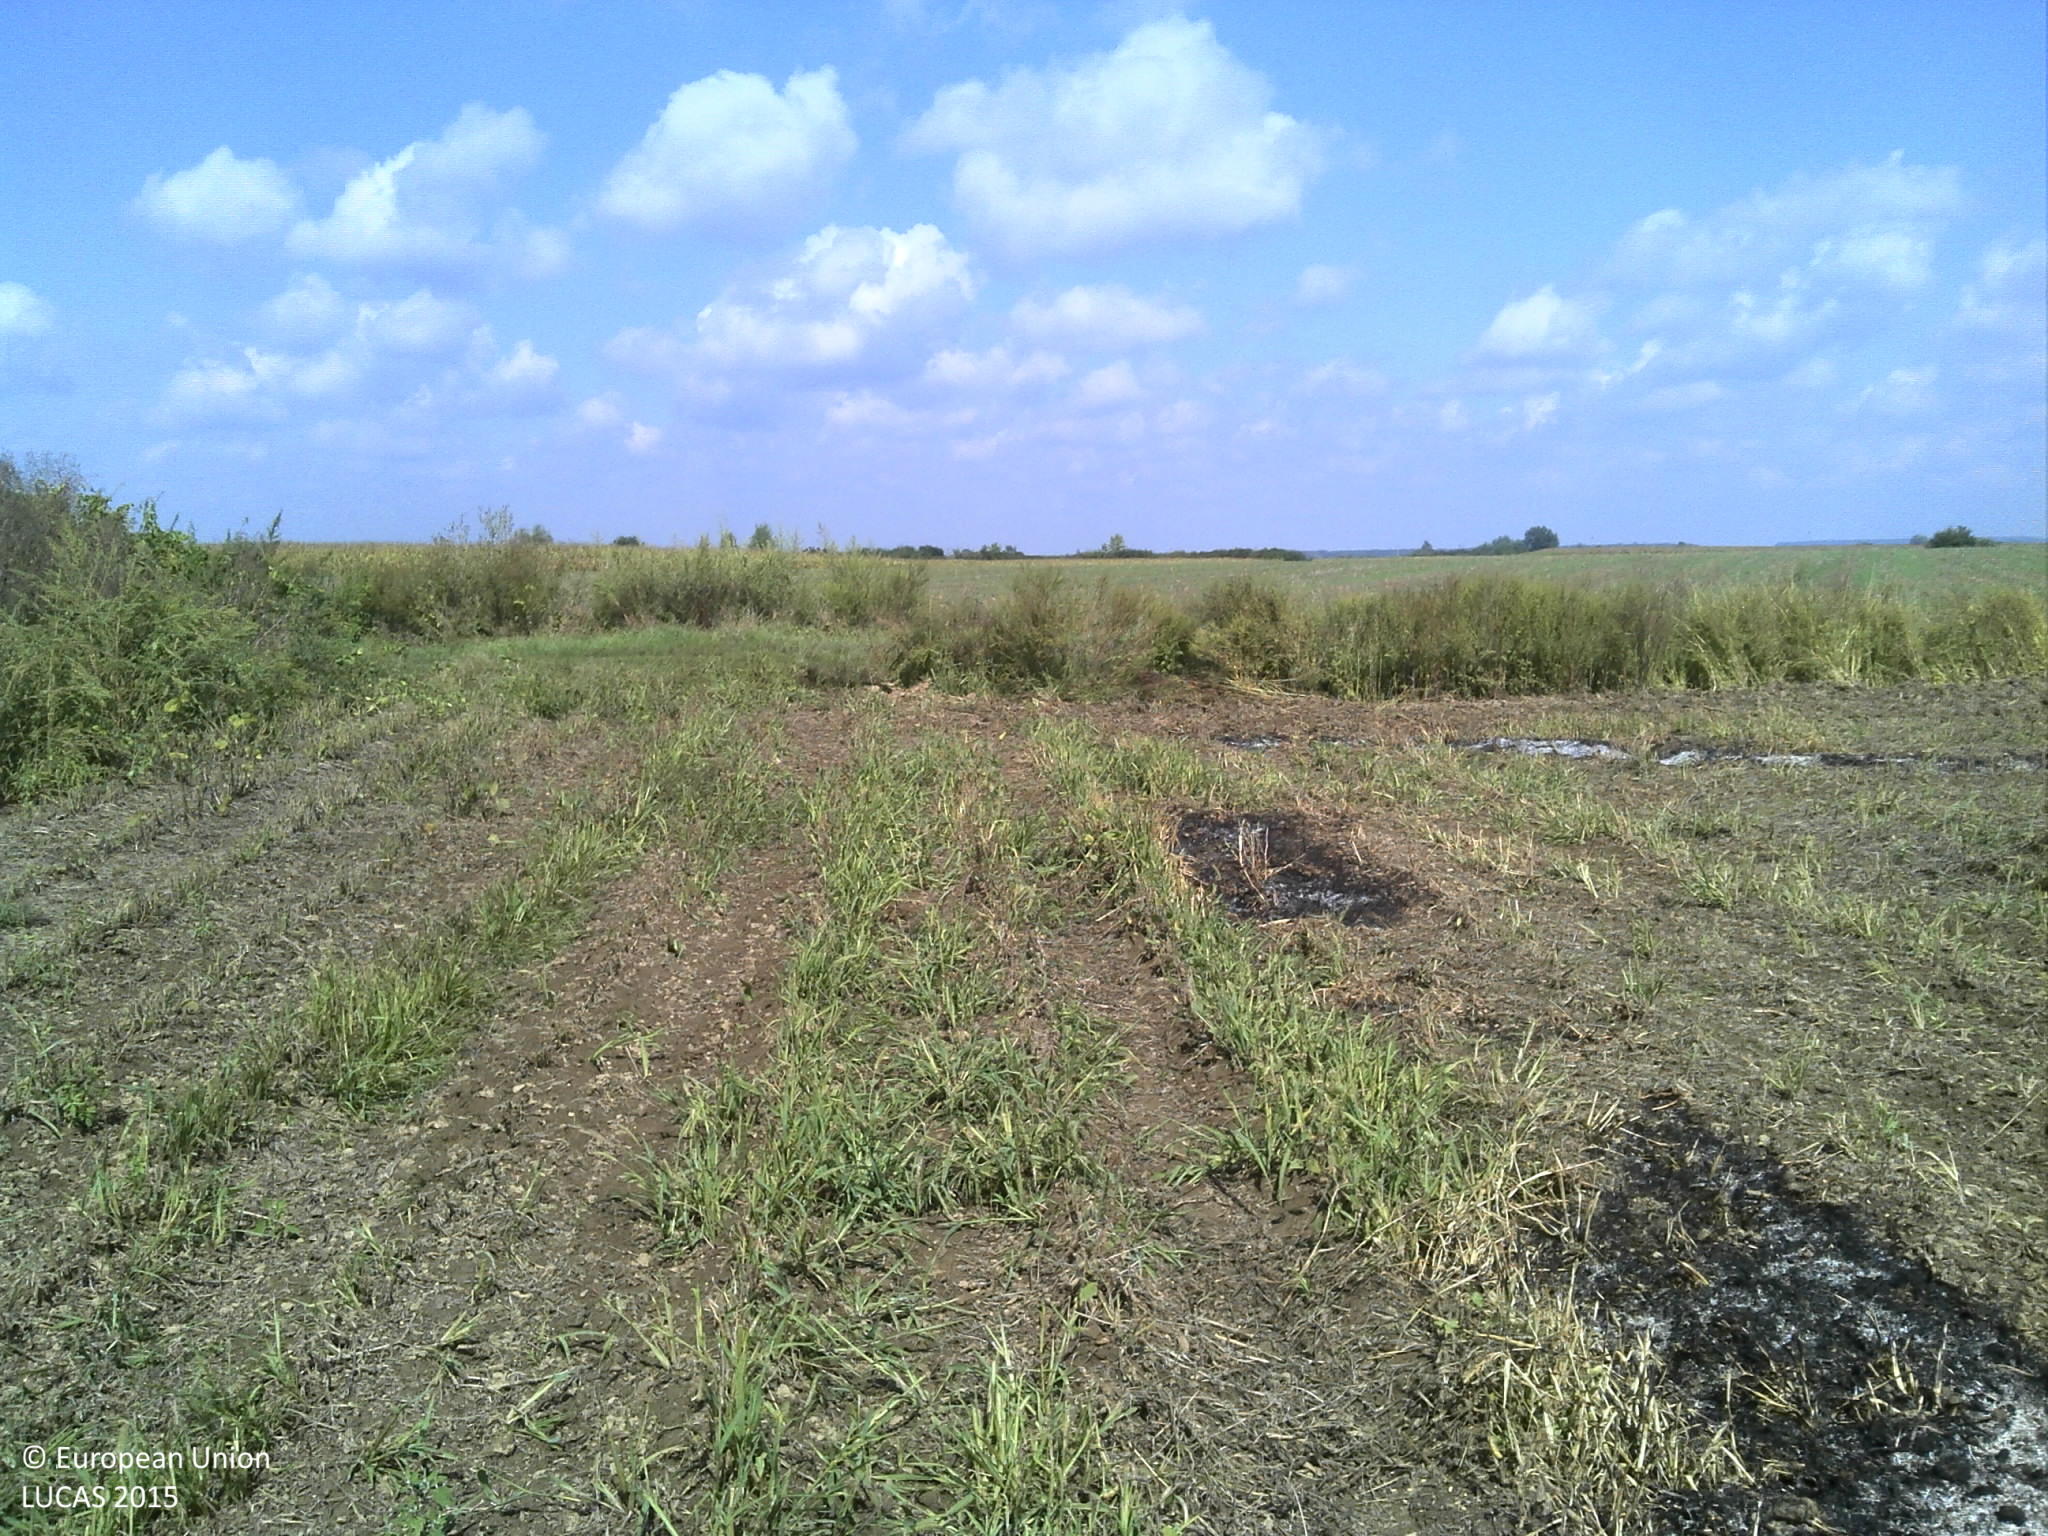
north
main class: Cropland
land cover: Soya
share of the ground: < 10 %
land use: Agriculture (excluding fallow land and kitchen gardens)
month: September
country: HR
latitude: 45.1398
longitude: 18.9730
